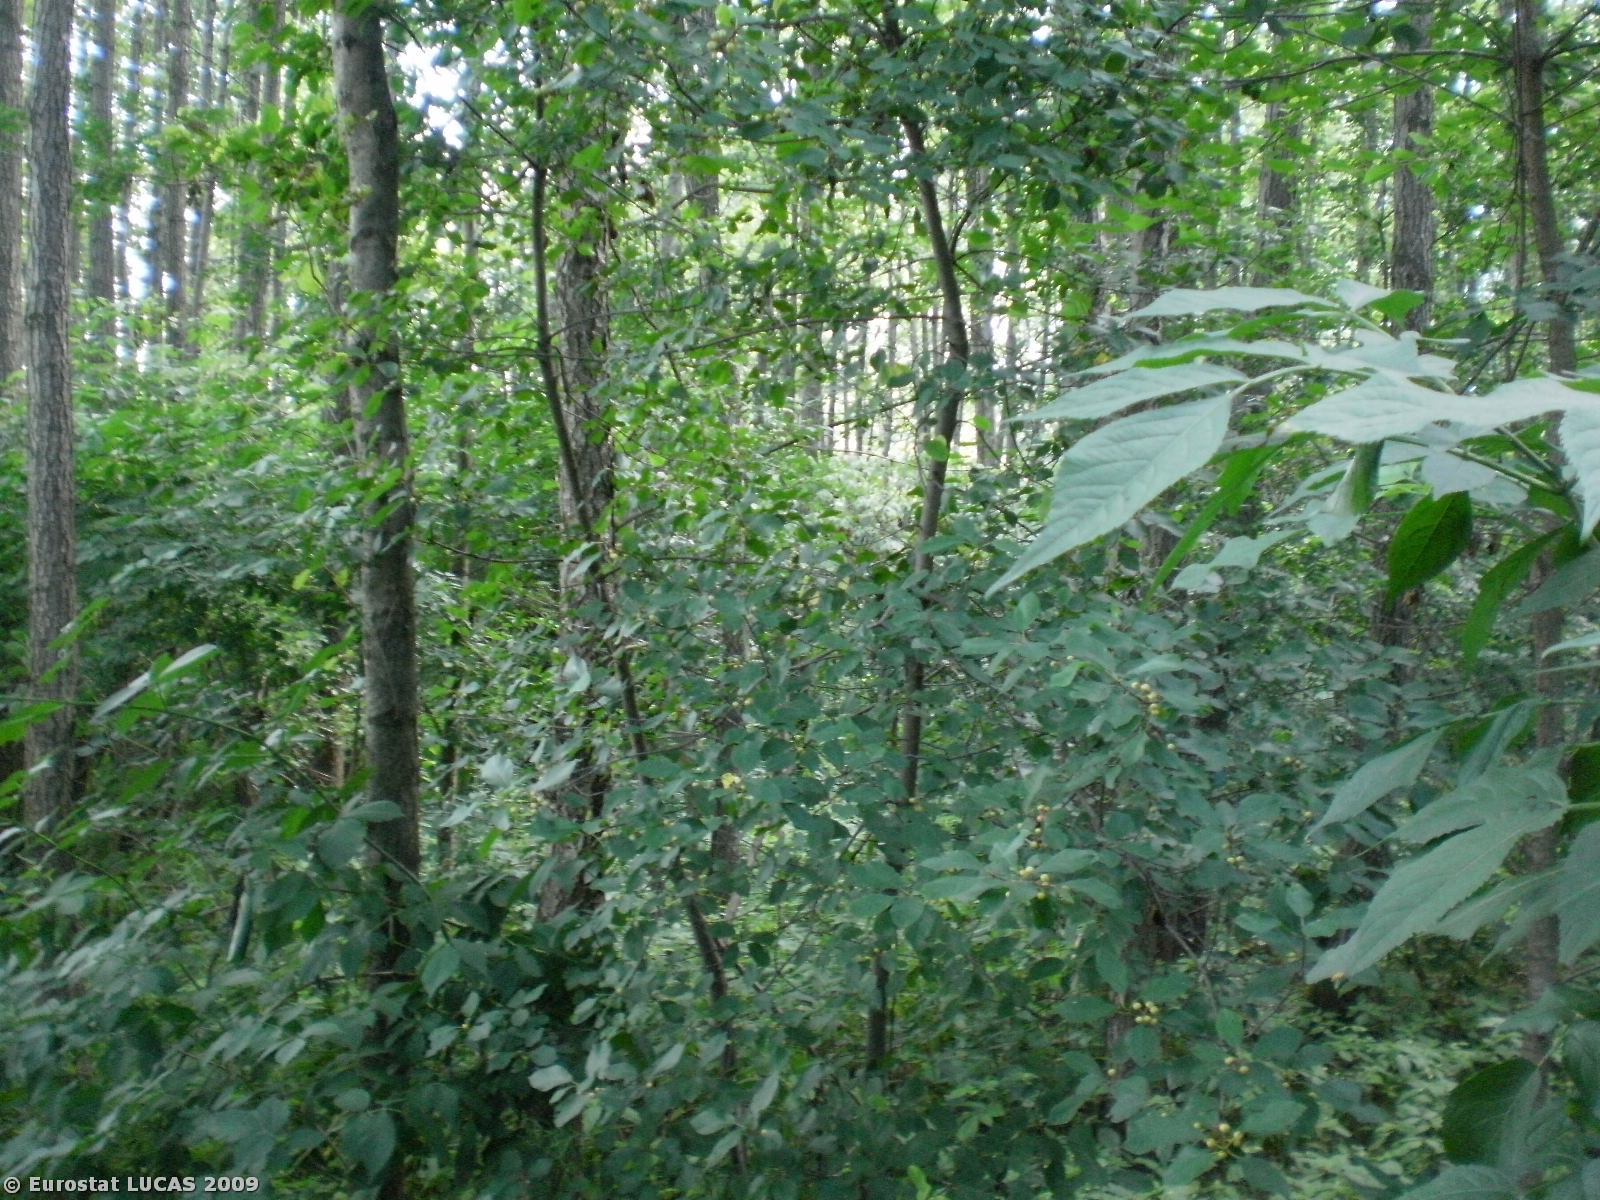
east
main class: Woodland
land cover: Broadleaved woodland
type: mire and swamp forests
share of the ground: > 75 %
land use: Unused
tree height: > 5 m
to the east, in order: Broadleaved woodland; Grassland without tree/shrub cover; Mixed woodland; Paved roads, cycling and walking lanes; Mixed woodland
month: August
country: PL
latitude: 53.8678
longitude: 20.5149
